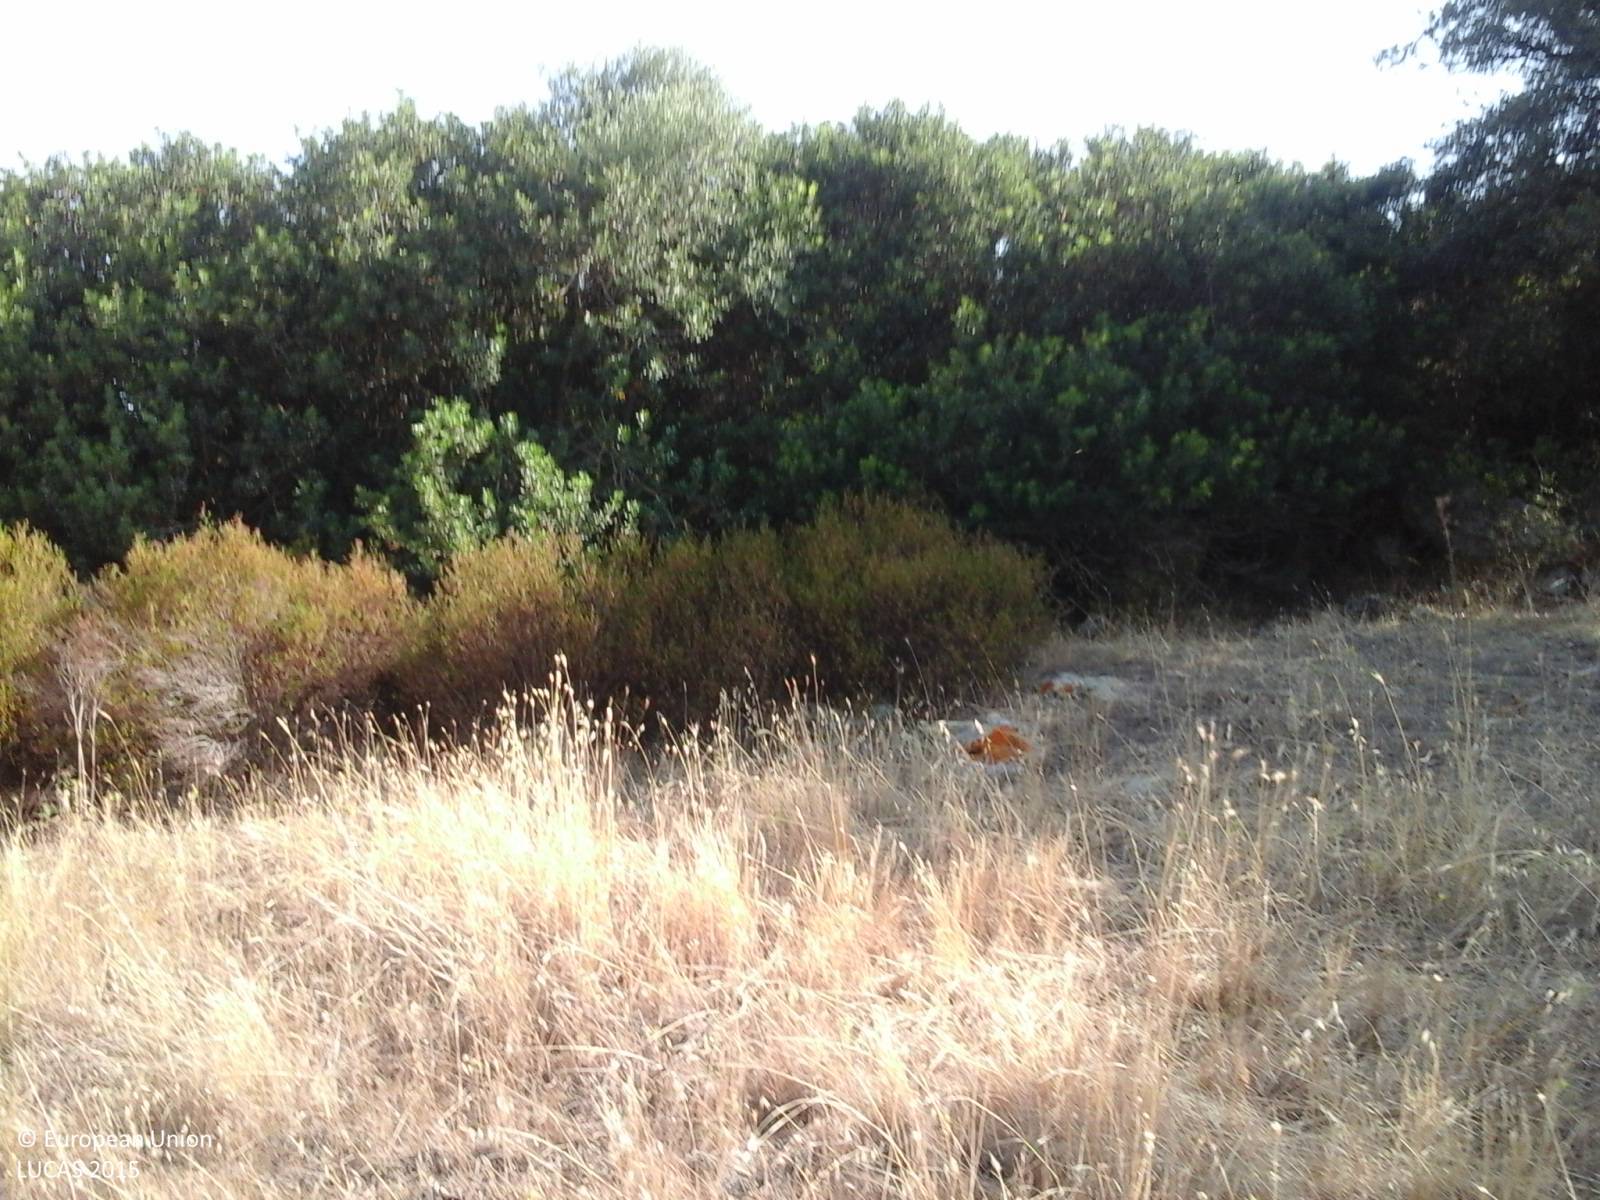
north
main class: Grassland
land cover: Grassland with sparse tree/shrub cover
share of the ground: > 75 %
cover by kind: herbaceous plants 85 %, shrubs 10 %, broadleaved forest trees 5 %
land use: Agriculture (excluding fallow land and kitchen gardens)
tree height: < 5 m
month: July
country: IT
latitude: 39.9171
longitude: 8.8947
